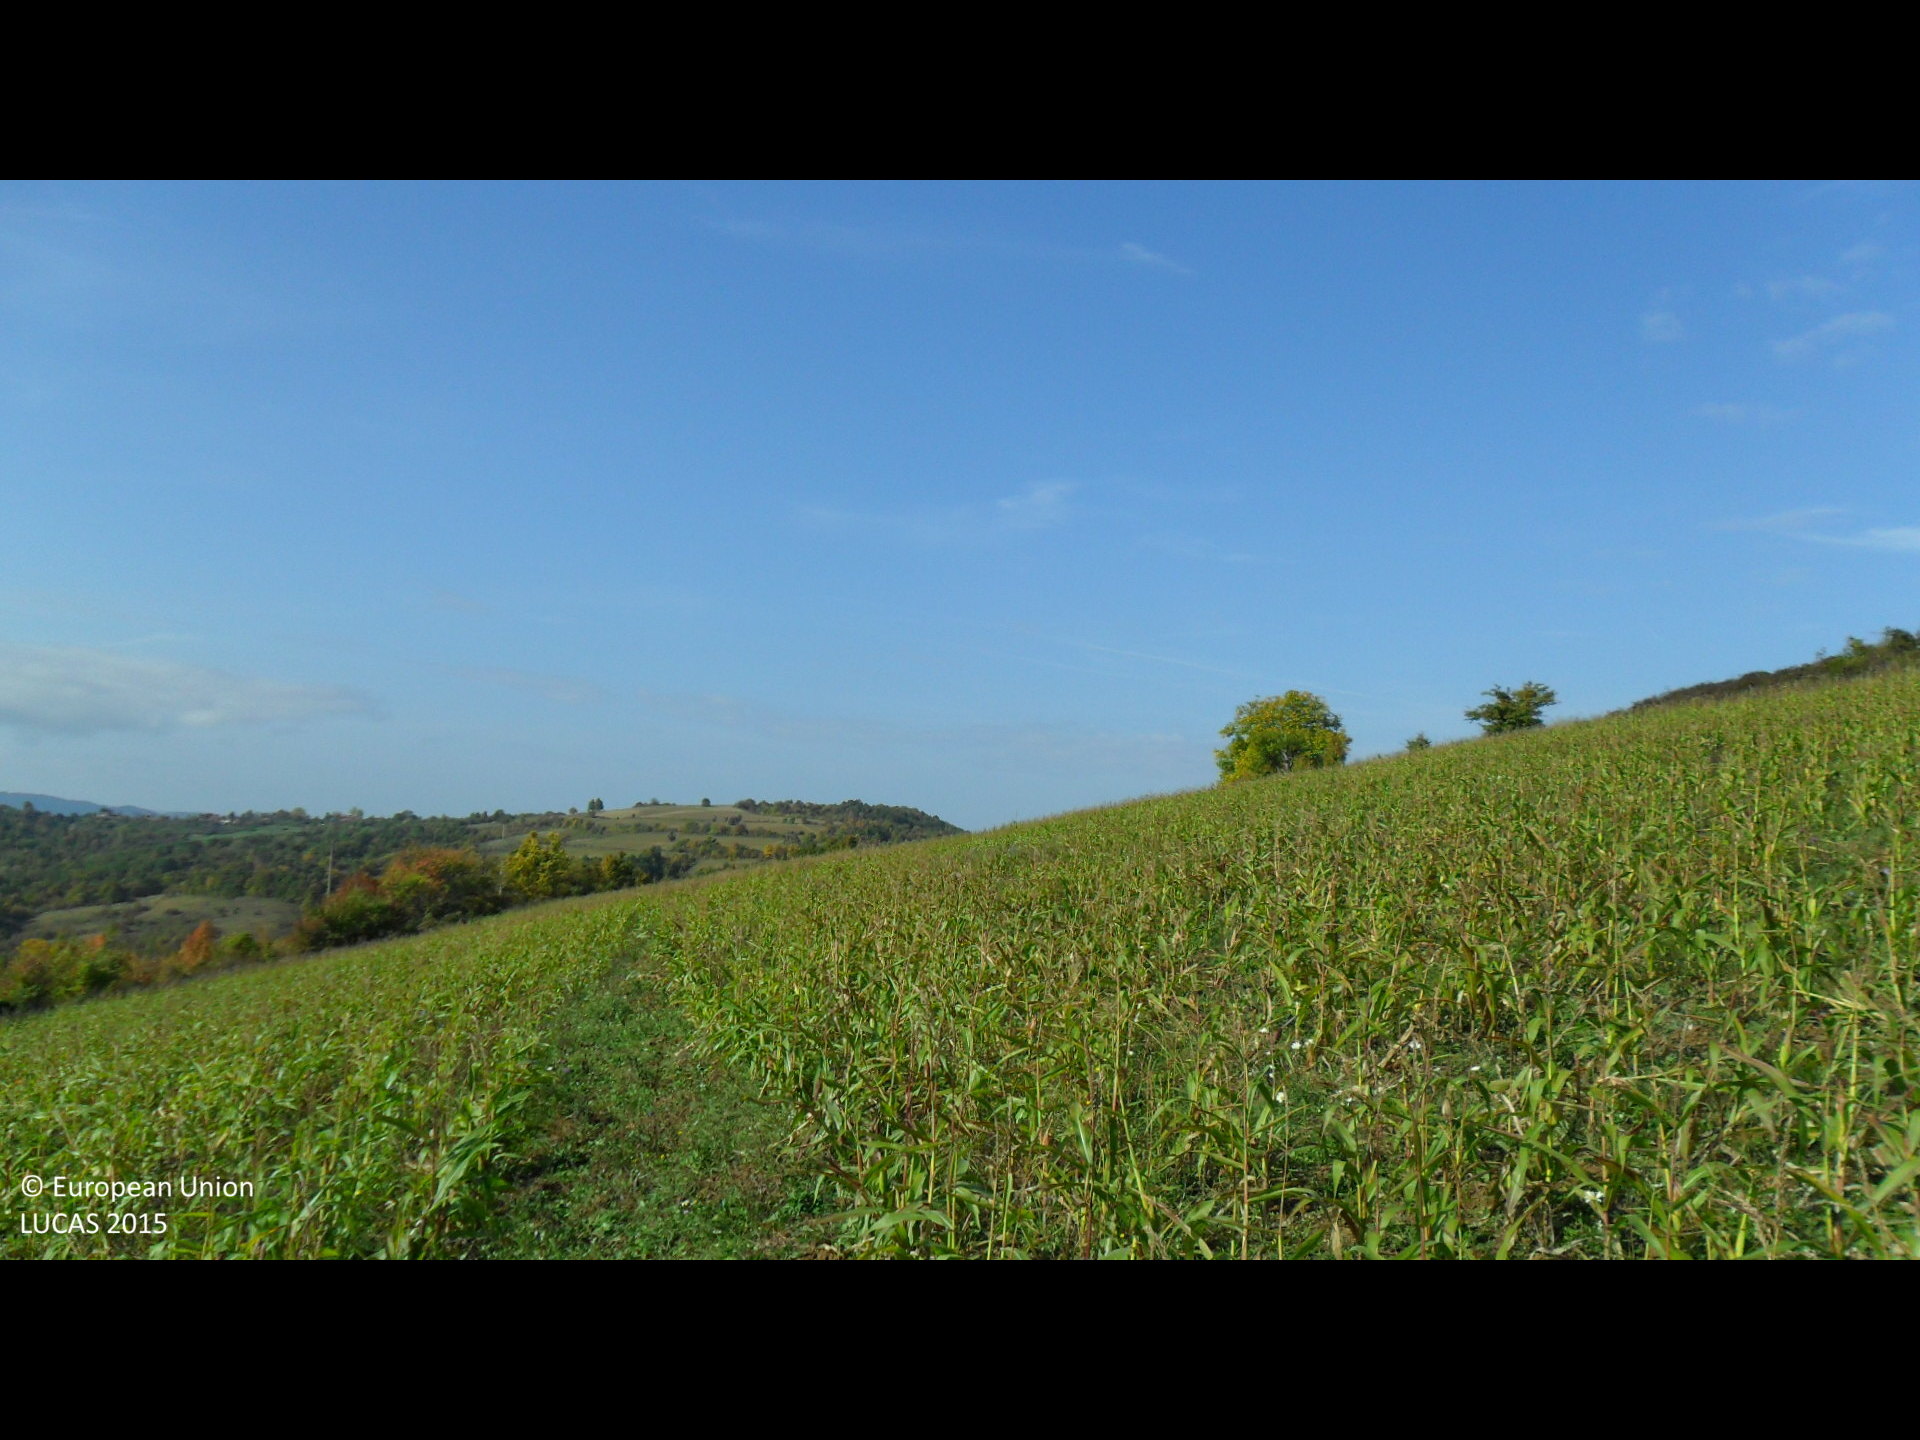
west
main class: Cropland
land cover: Maize
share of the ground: > 75 %
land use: Agriculture (excluding fallow land and kitchen gardens)
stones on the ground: < 10 %
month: October
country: BG
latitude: 43.0940
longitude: 26.1485
